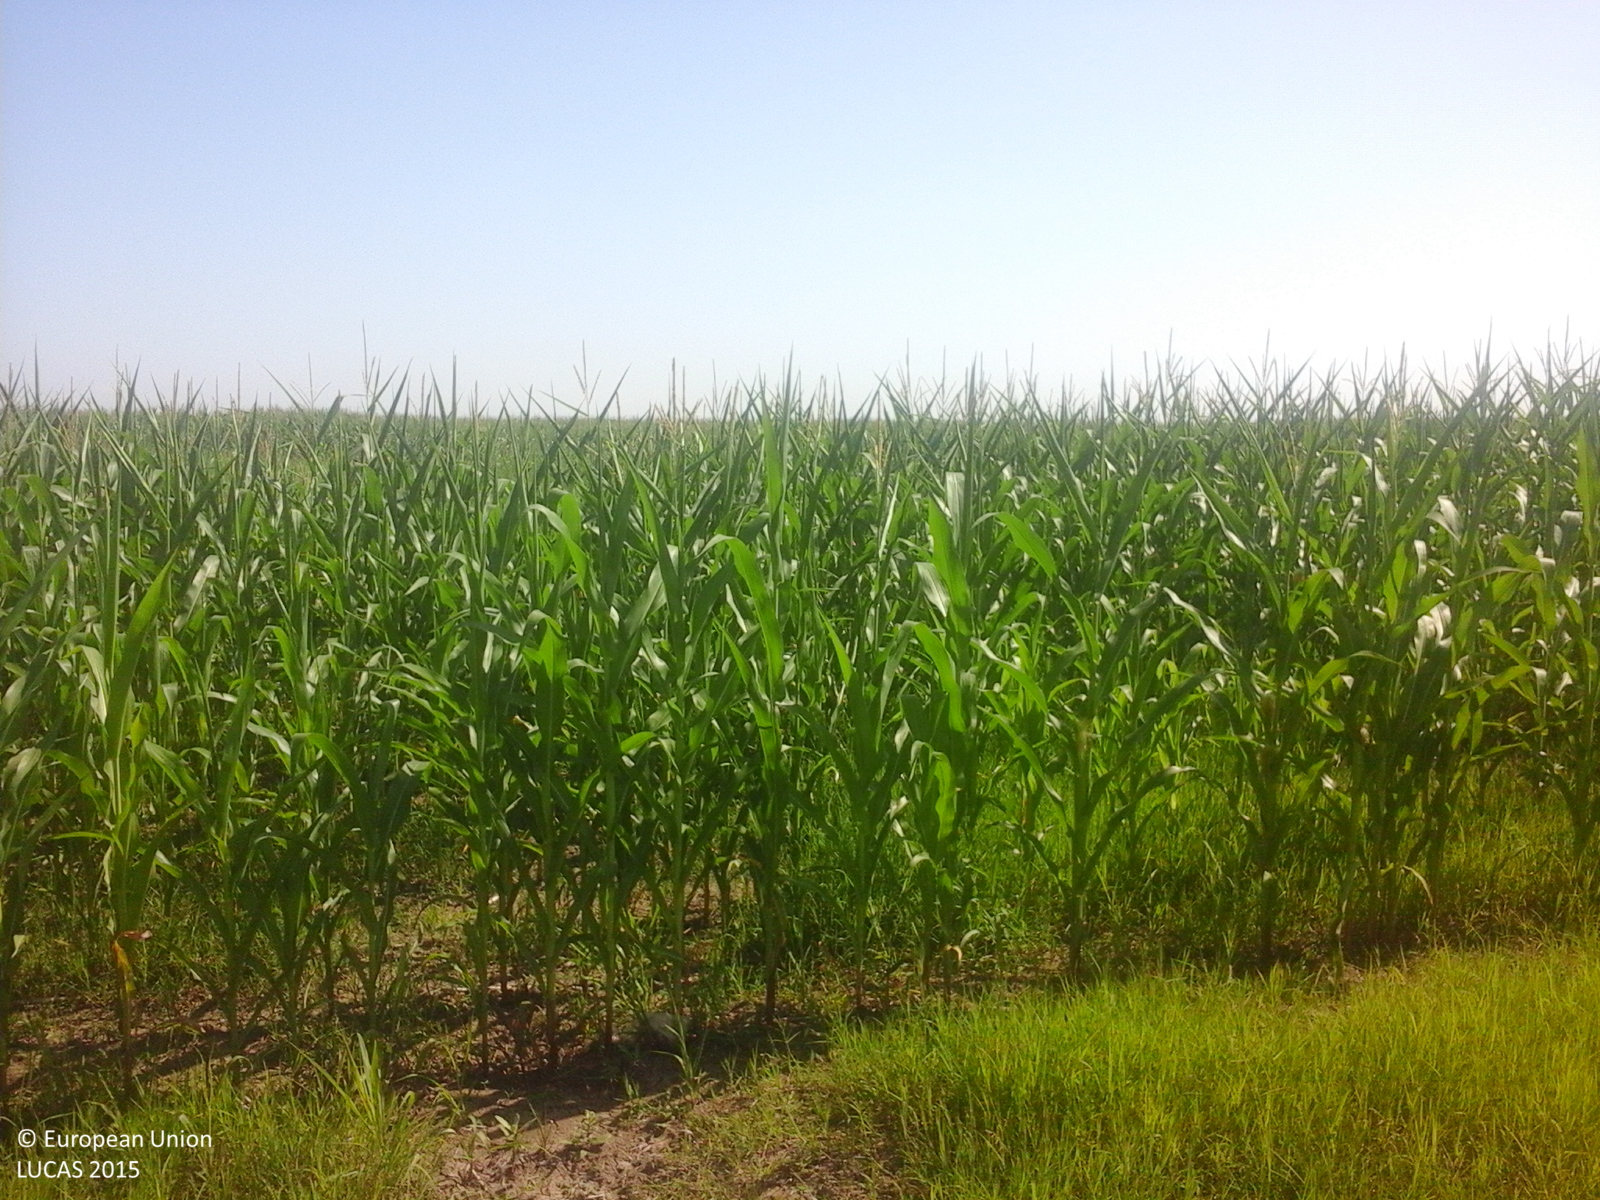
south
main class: Cropland
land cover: Maize
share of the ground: > 75 %
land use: Agriculture (excluding fallow land and kitchen gardens)
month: July
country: RO
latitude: 44.4158
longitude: 24.2957
